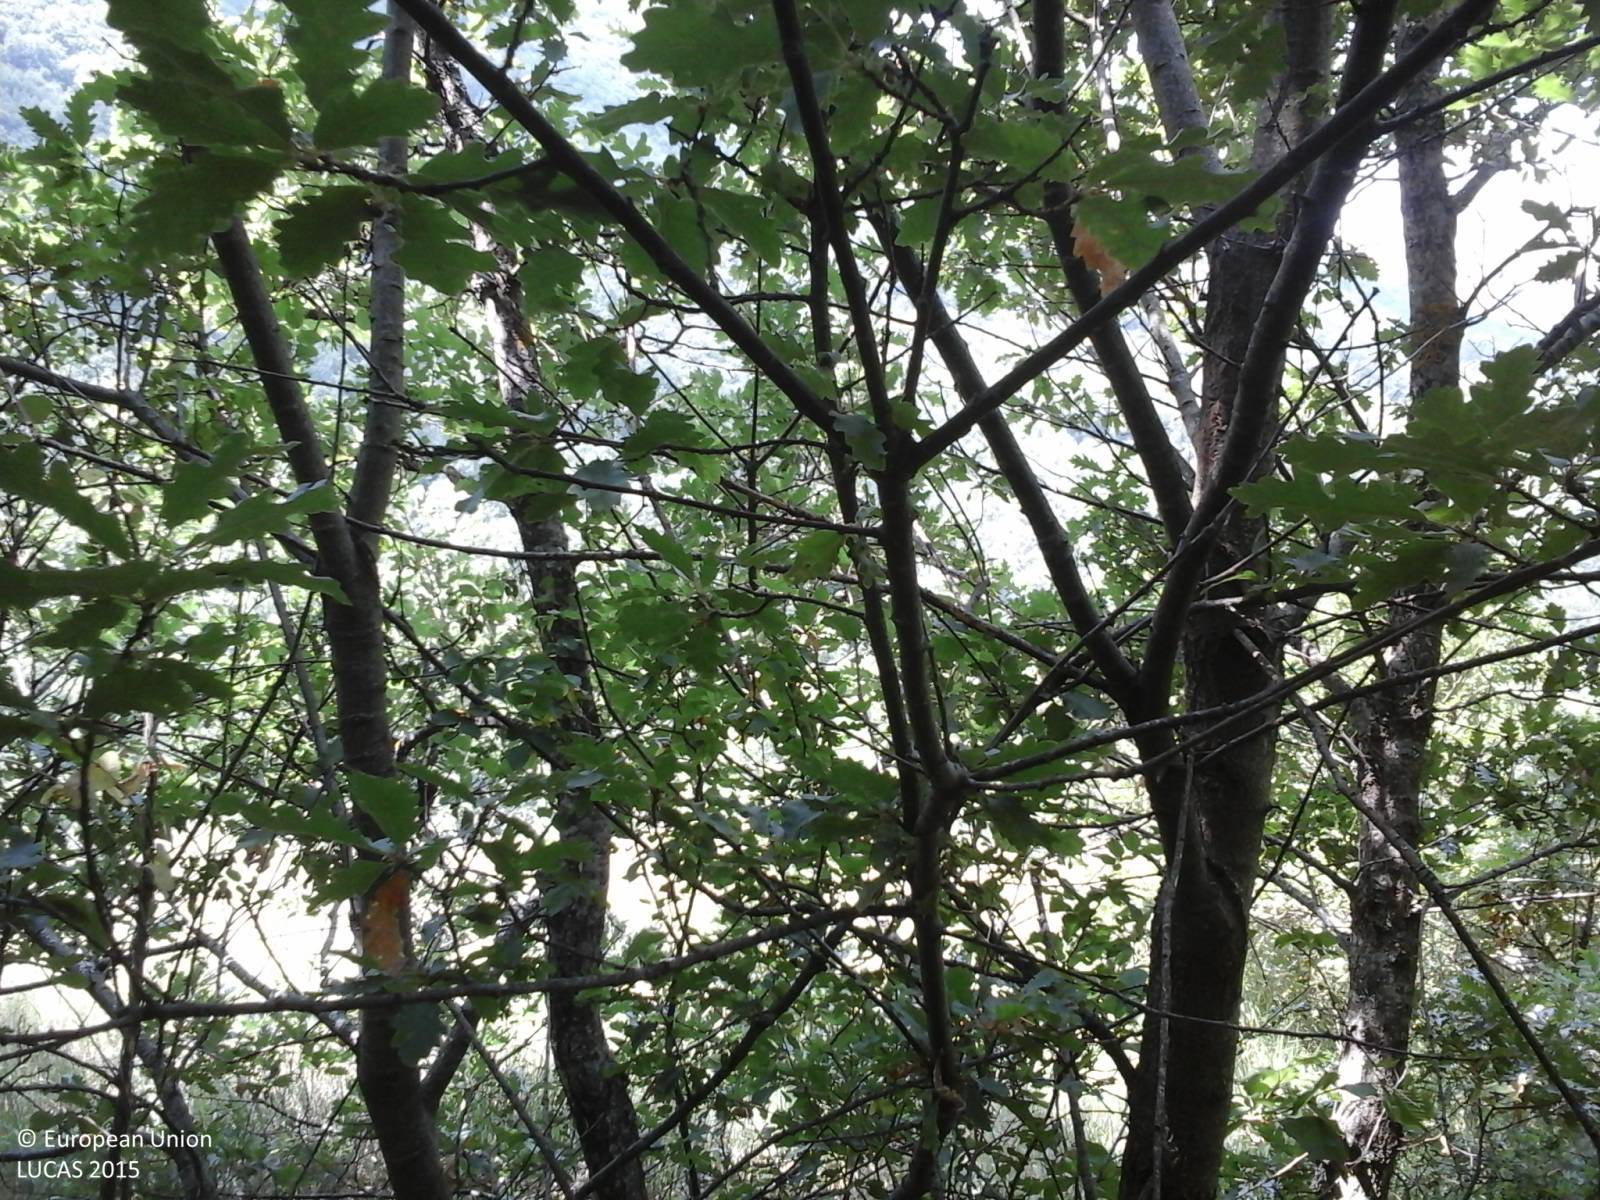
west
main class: Woodland
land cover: Broadleaved woodland
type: thermophilous deciduous forest
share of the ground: > 75 %
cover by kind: broadleaved forest trees 100 %
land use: Forestry
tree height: > 5 m
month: July
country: IT
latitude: 42.4397
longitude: 13.2355
